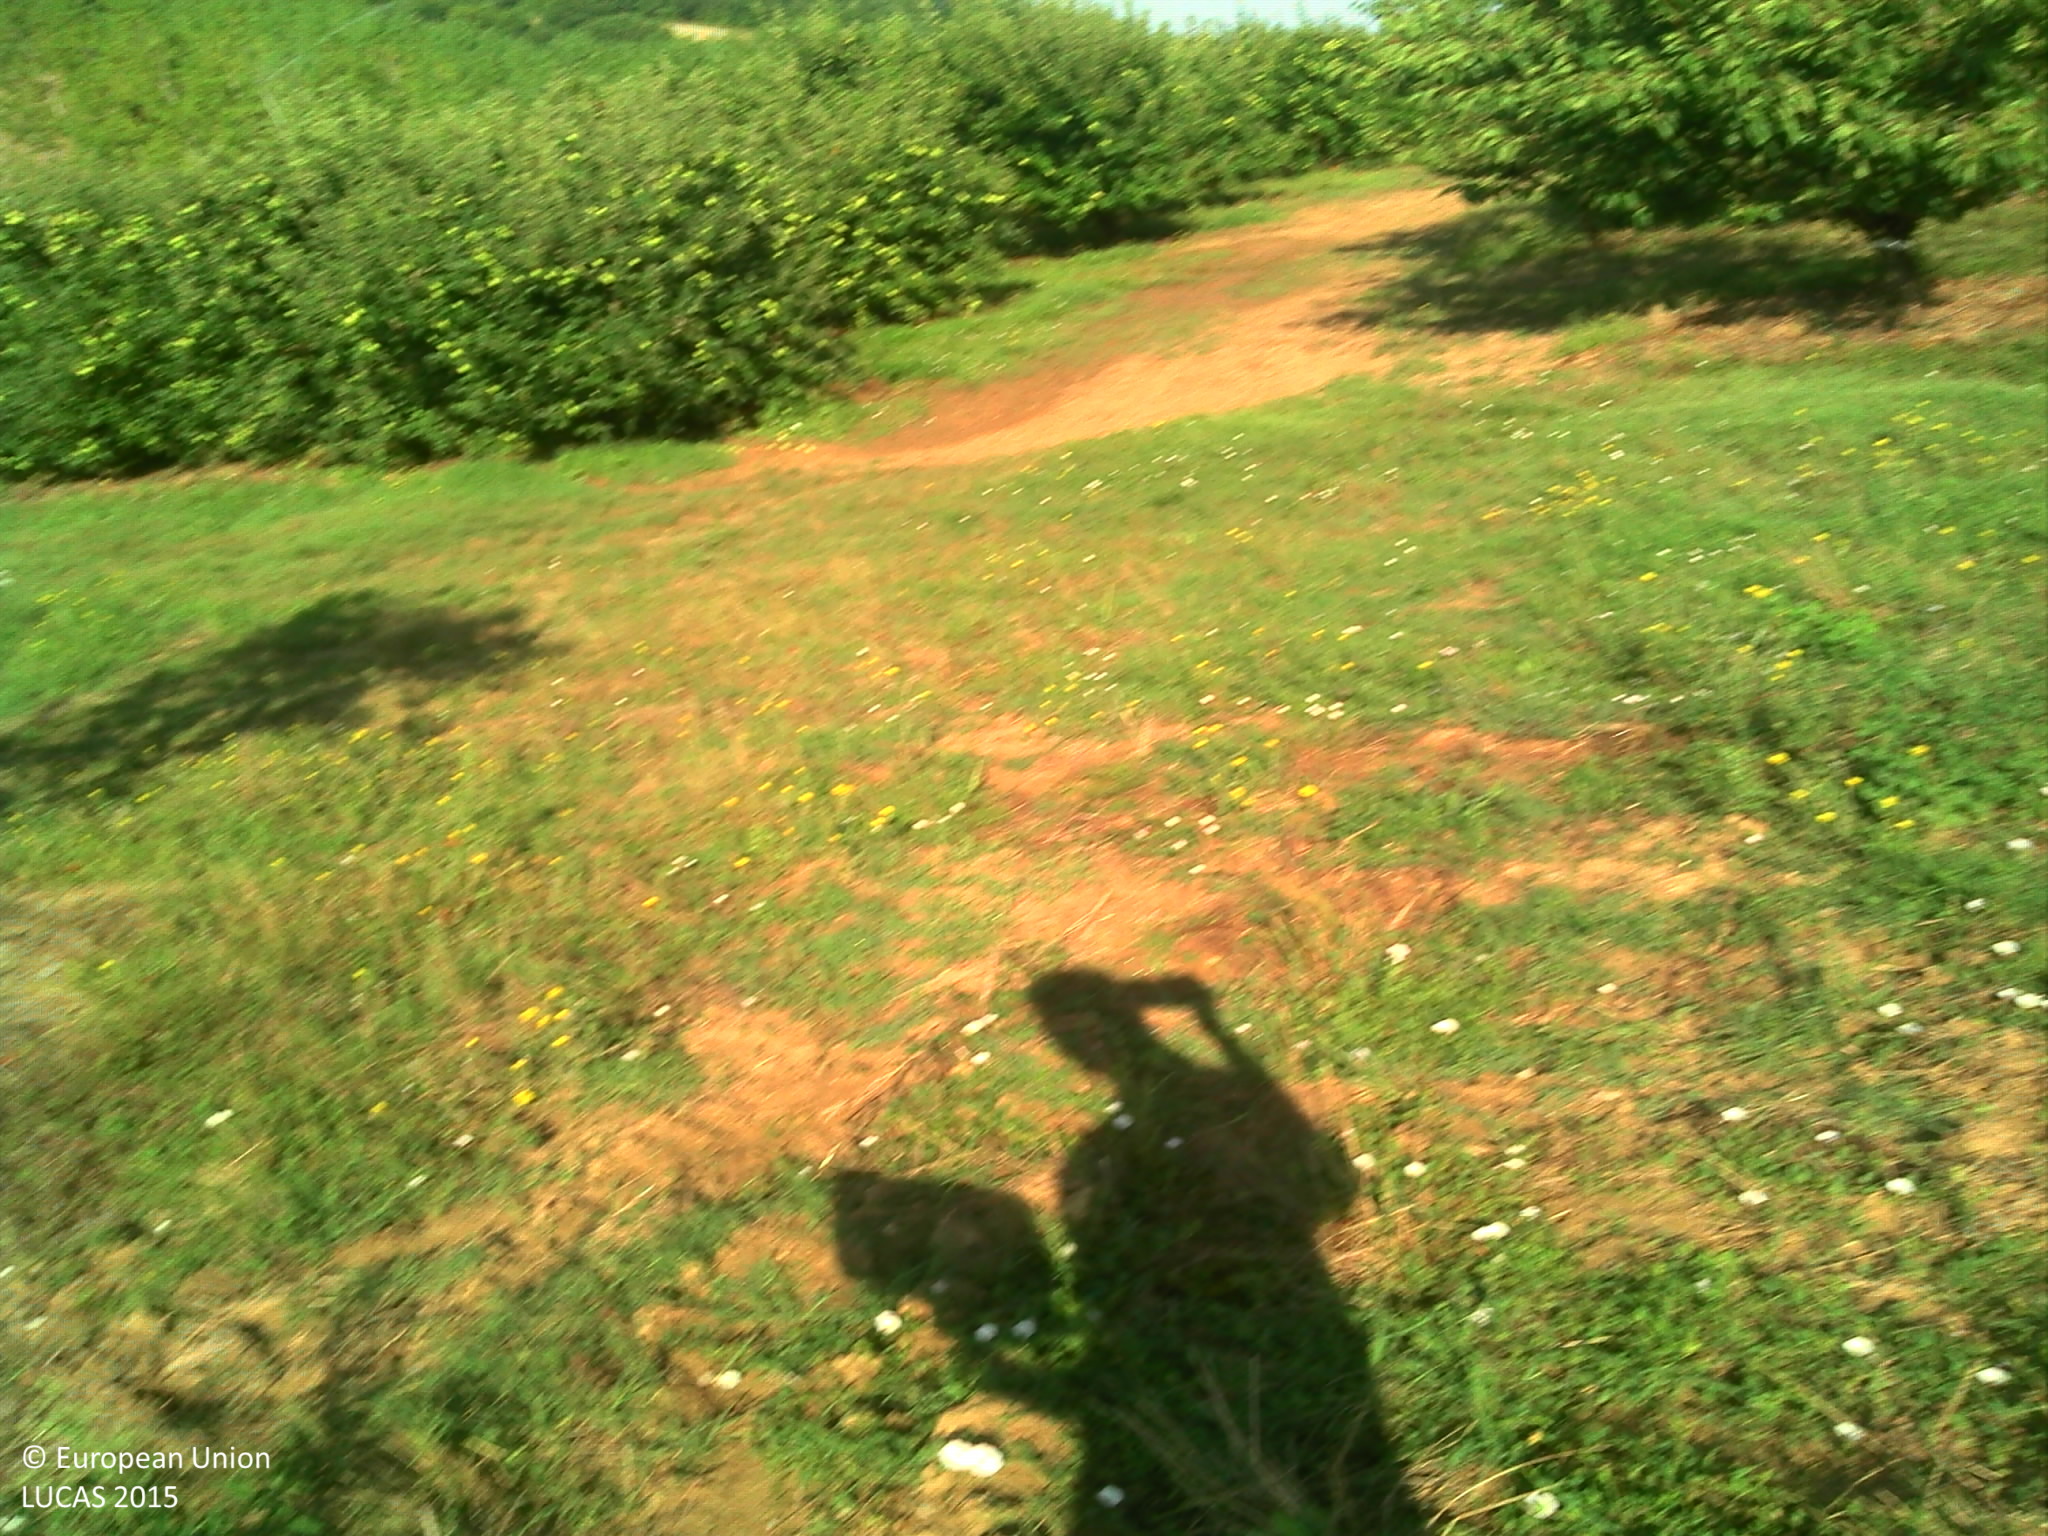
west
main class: Grassland
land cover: Grassland without tree/shrub cover
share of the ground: > 75 %
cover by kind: herbaceous plants 100 %
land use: Agriculture (excluding fallow land and kitchen gardens)
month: August
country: FR
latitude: 44.0970
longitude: 1.3430
